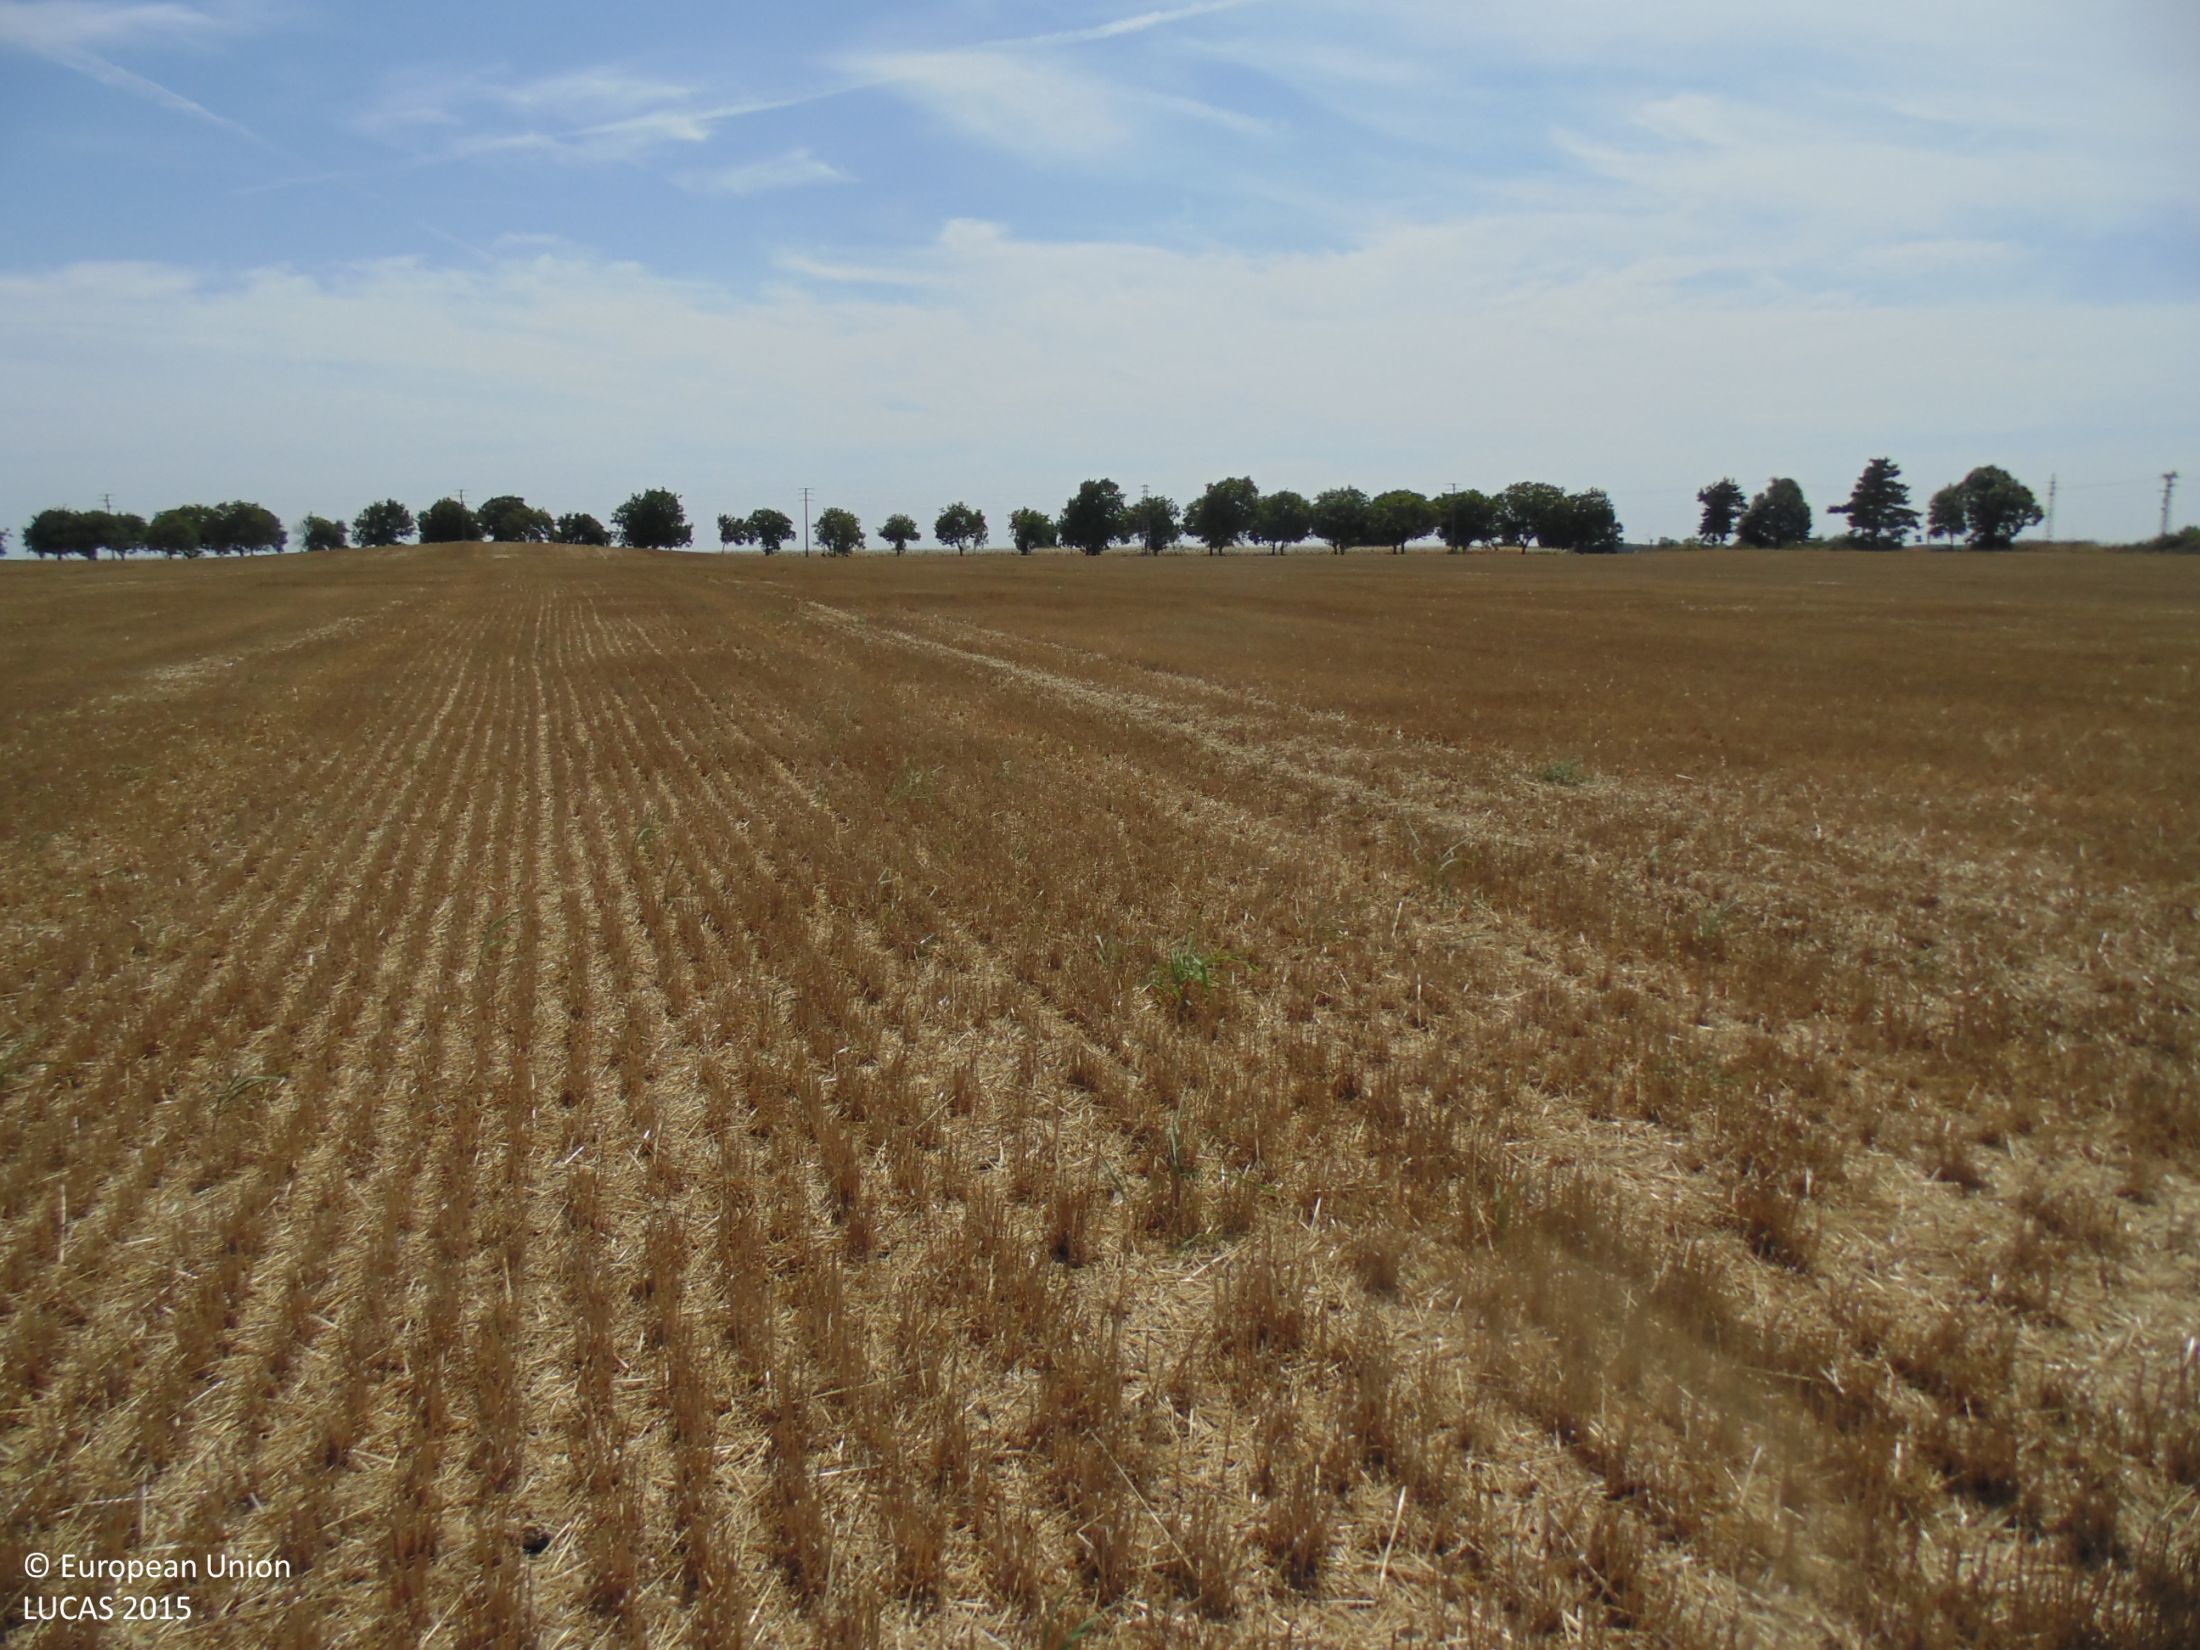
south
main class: Cropland
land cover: Common wheat
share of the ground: 25 - 50 %
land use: Agriculture (excluding fallow land and kitchen gardens)
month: August
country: BG
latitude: 43.6262
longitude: 28.5178
